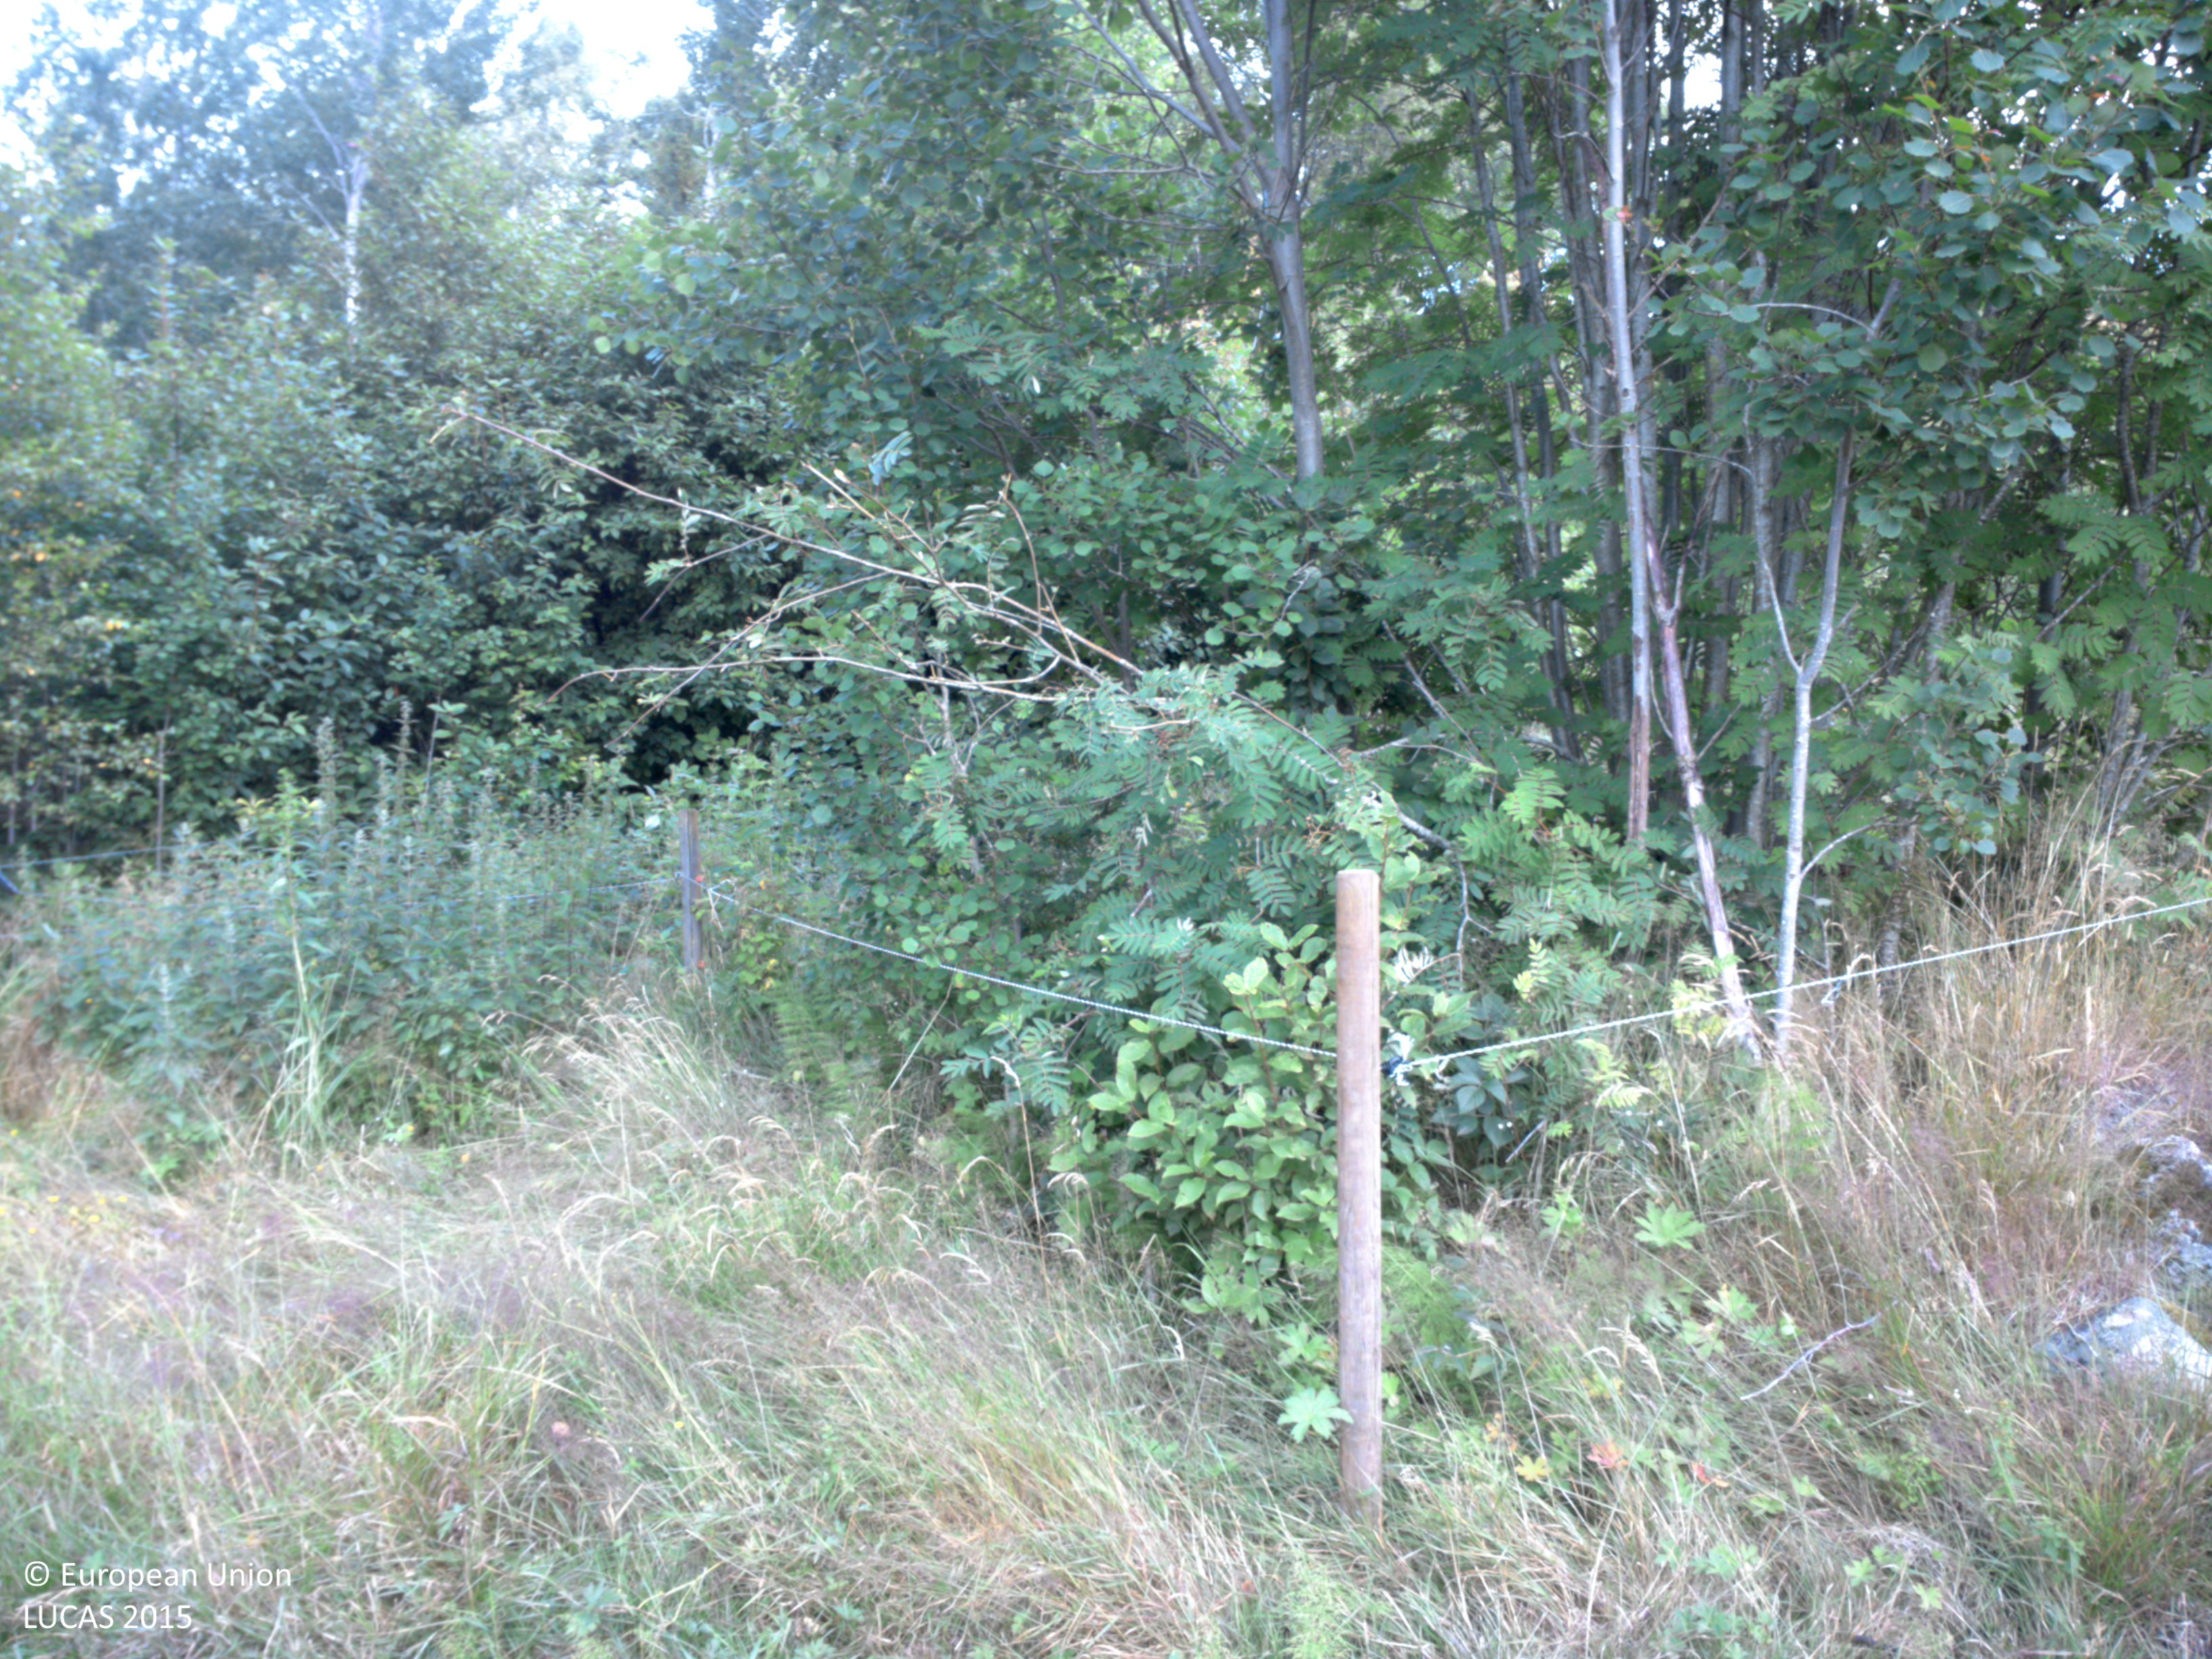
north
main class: Grassland
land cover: Grassland without tree/shrub cover
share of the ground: > 75 %
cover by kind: herbaceous plants 80 %, unconsolidated bare surface 20 %
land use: Agriculture (excluding fallow land and kitchen gardens)
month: July
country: SE
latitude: 58.6392
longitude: 11.8050
